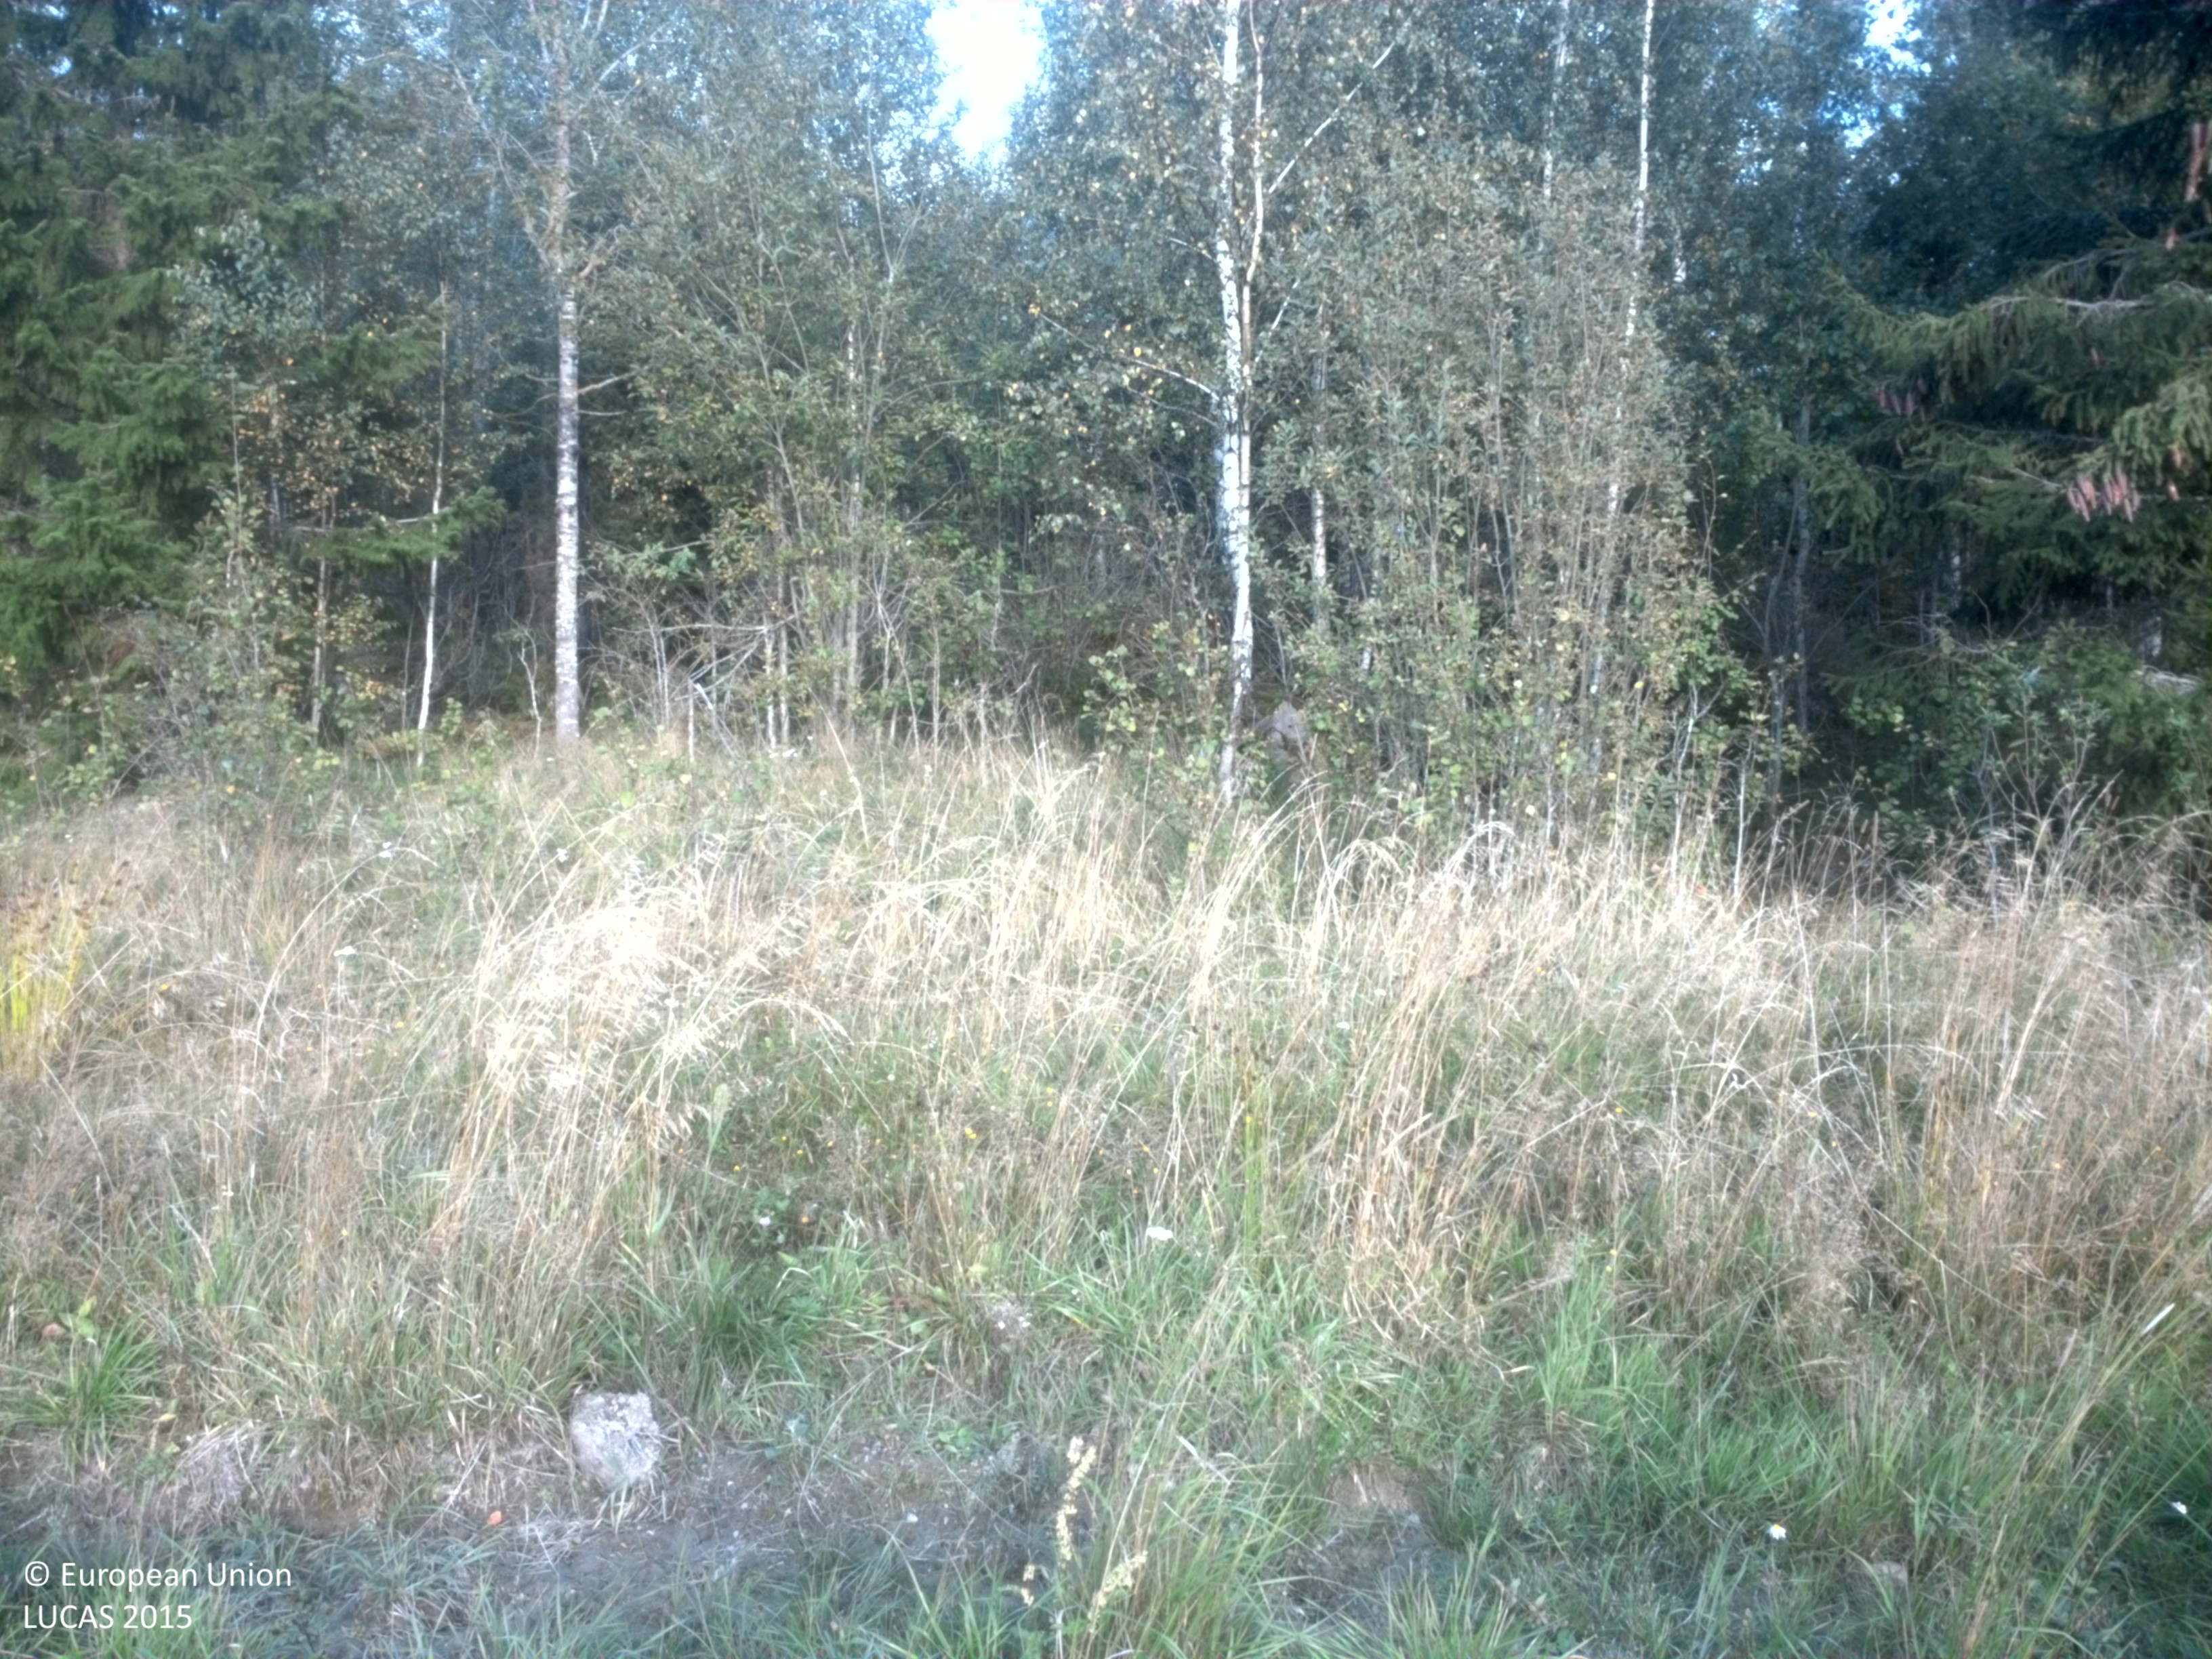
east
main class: Cropland
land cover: Mixed cereals for fodder
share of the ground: > 75 %
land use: Agriculture (excluding fallow land and kitchen gardens)
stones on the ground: < 10 %
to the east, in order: Mixed cereals for fodder; Tracks; Grass margins; Broadleaved woodland; Rock outcrops; Broadleaved woodland; Shrubland with sparse tree cover; Tracks; Shrubland with sparse tree cover; Mixed cereals for fodder
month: September
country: SE
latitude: 59.4745
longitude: 15.5866
